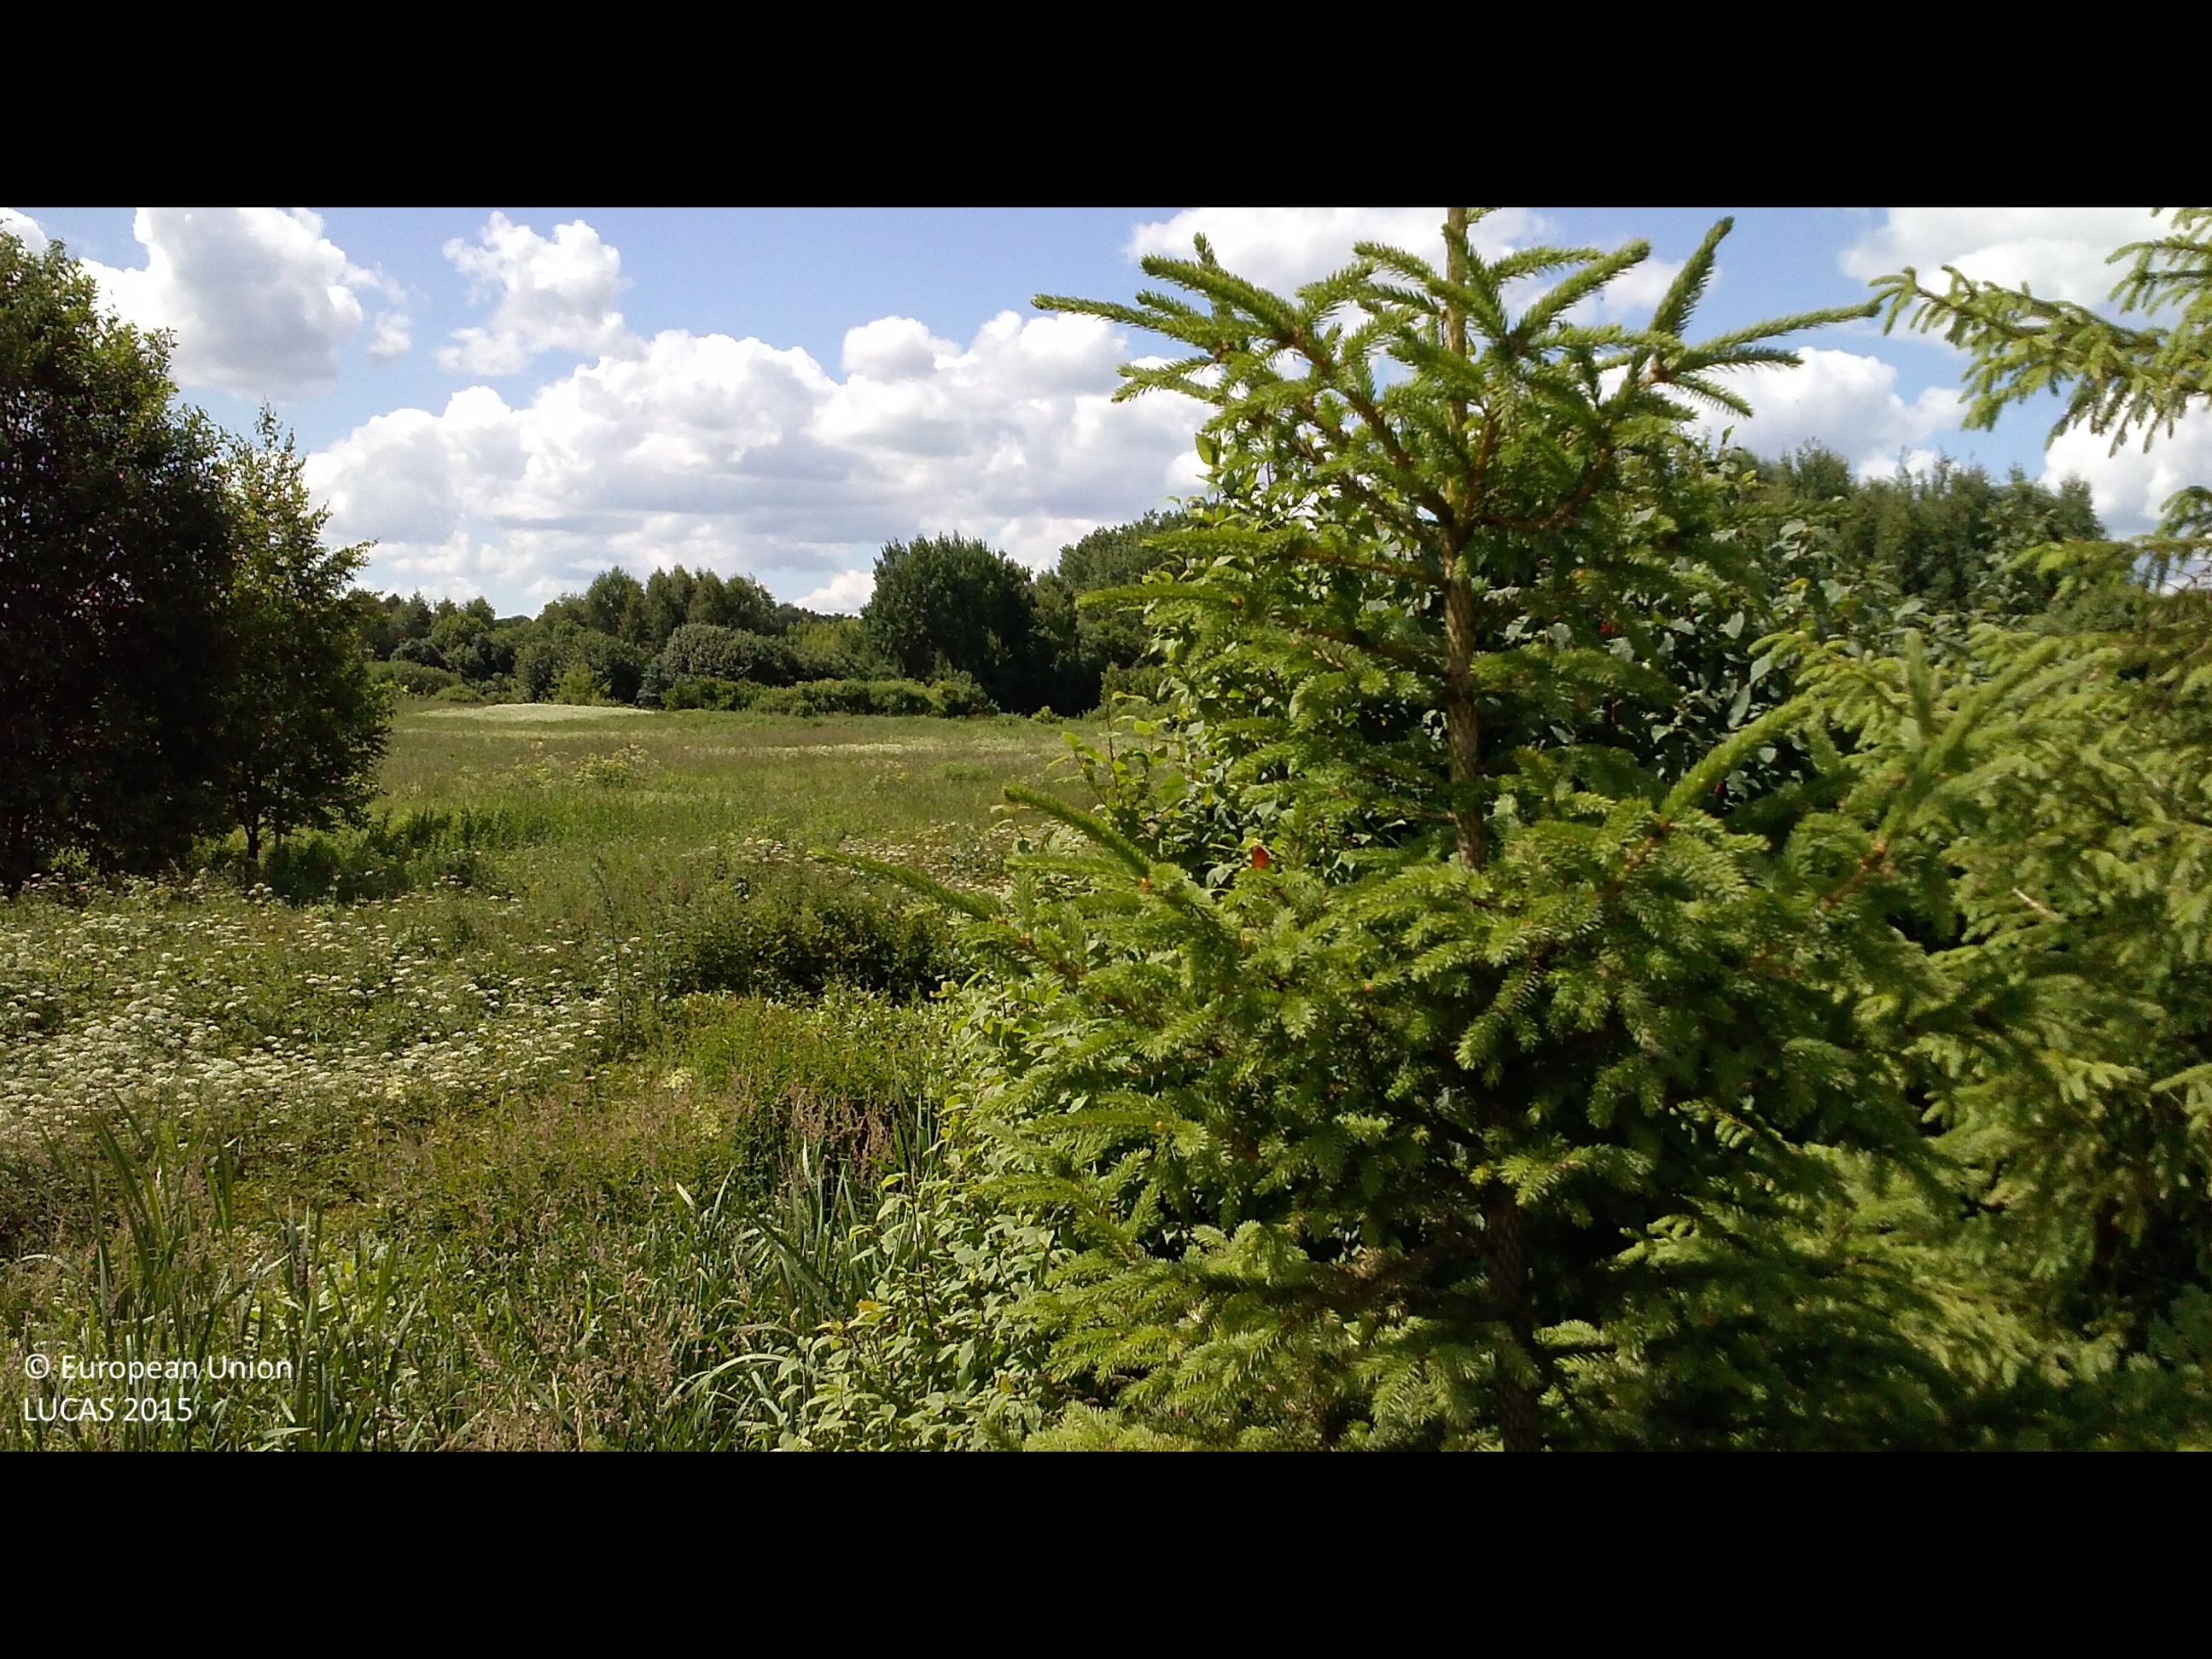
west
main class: Grassland
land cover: Grassland without tree/shrub cover
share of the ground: > 75 %
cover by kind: herbaceous plants 100 %
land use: Agriculture (excluding fallow land and kitchen gardens)
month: June
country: LV
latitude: 56.5438
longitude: 27.7360
